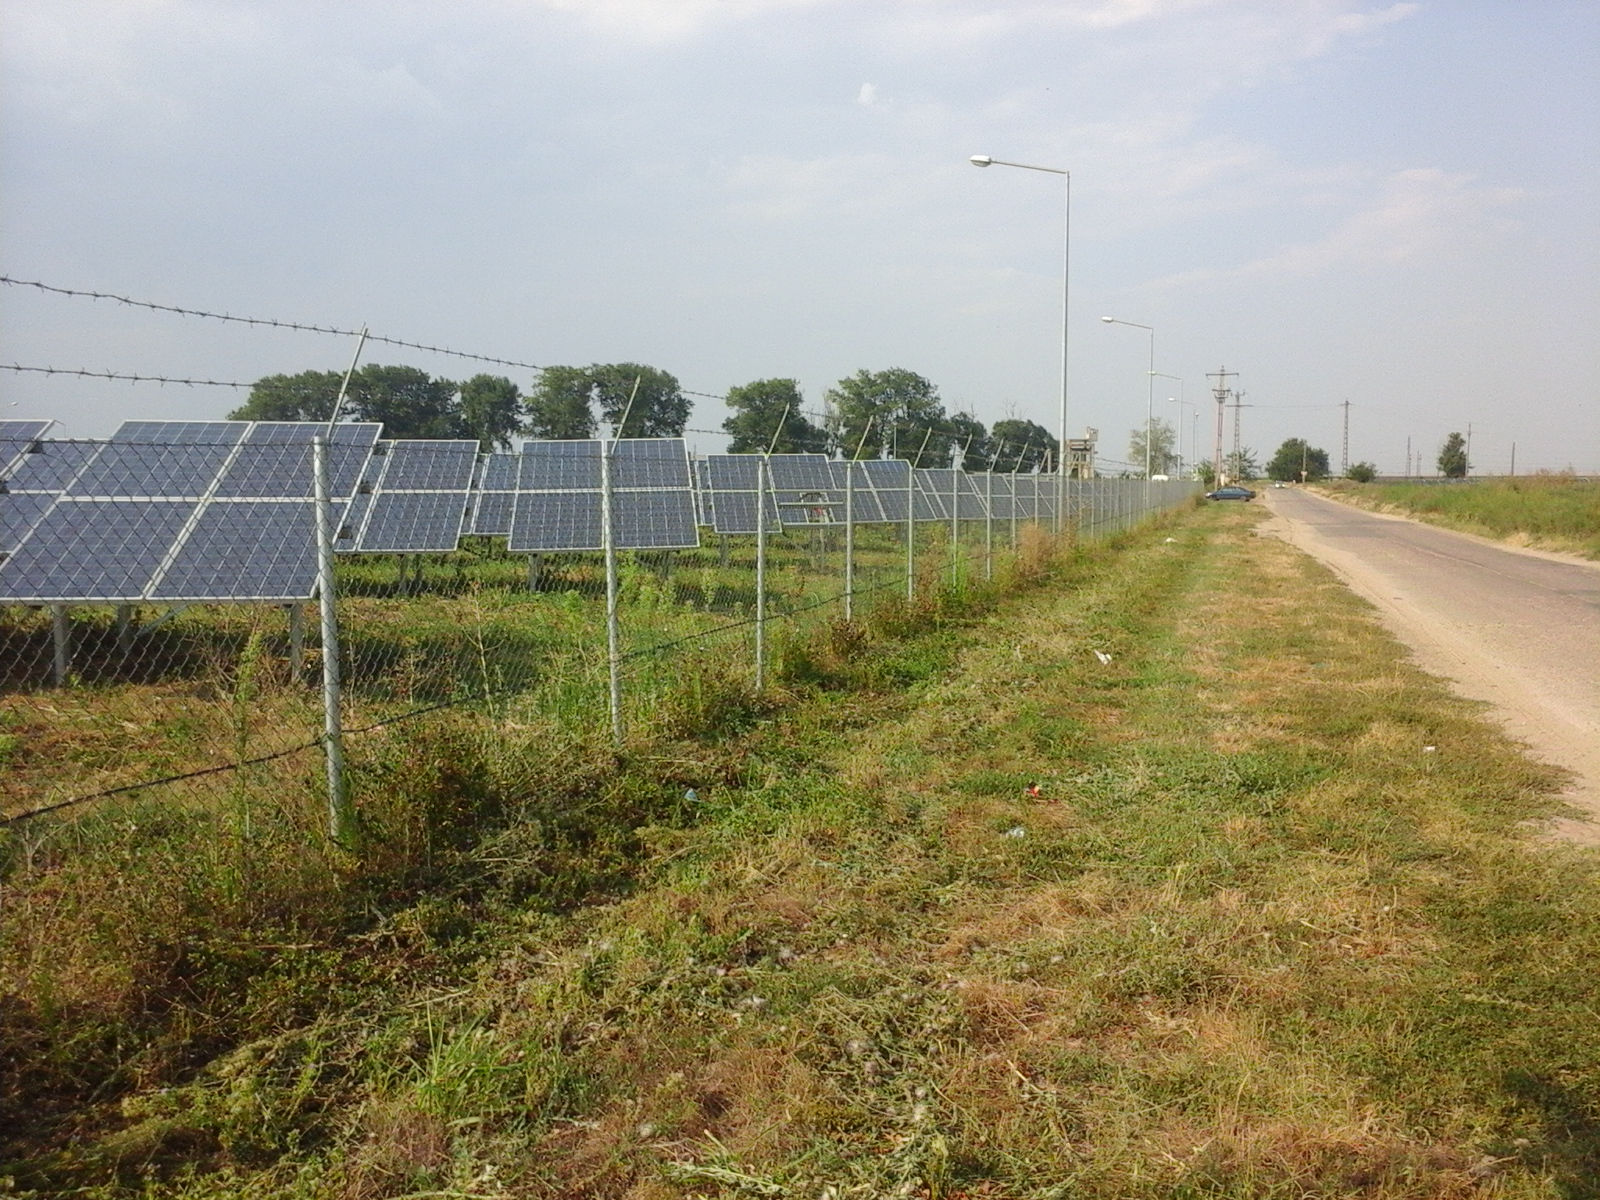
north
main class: Artificial land
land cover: Other artificial areas
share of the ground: > 75 %
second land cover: Grassland without tree/shrub cover
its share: > 75 %
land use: Electricity, gas and thermal power distribution
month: August
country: RO
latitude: 44.0301
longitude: 23.3603
